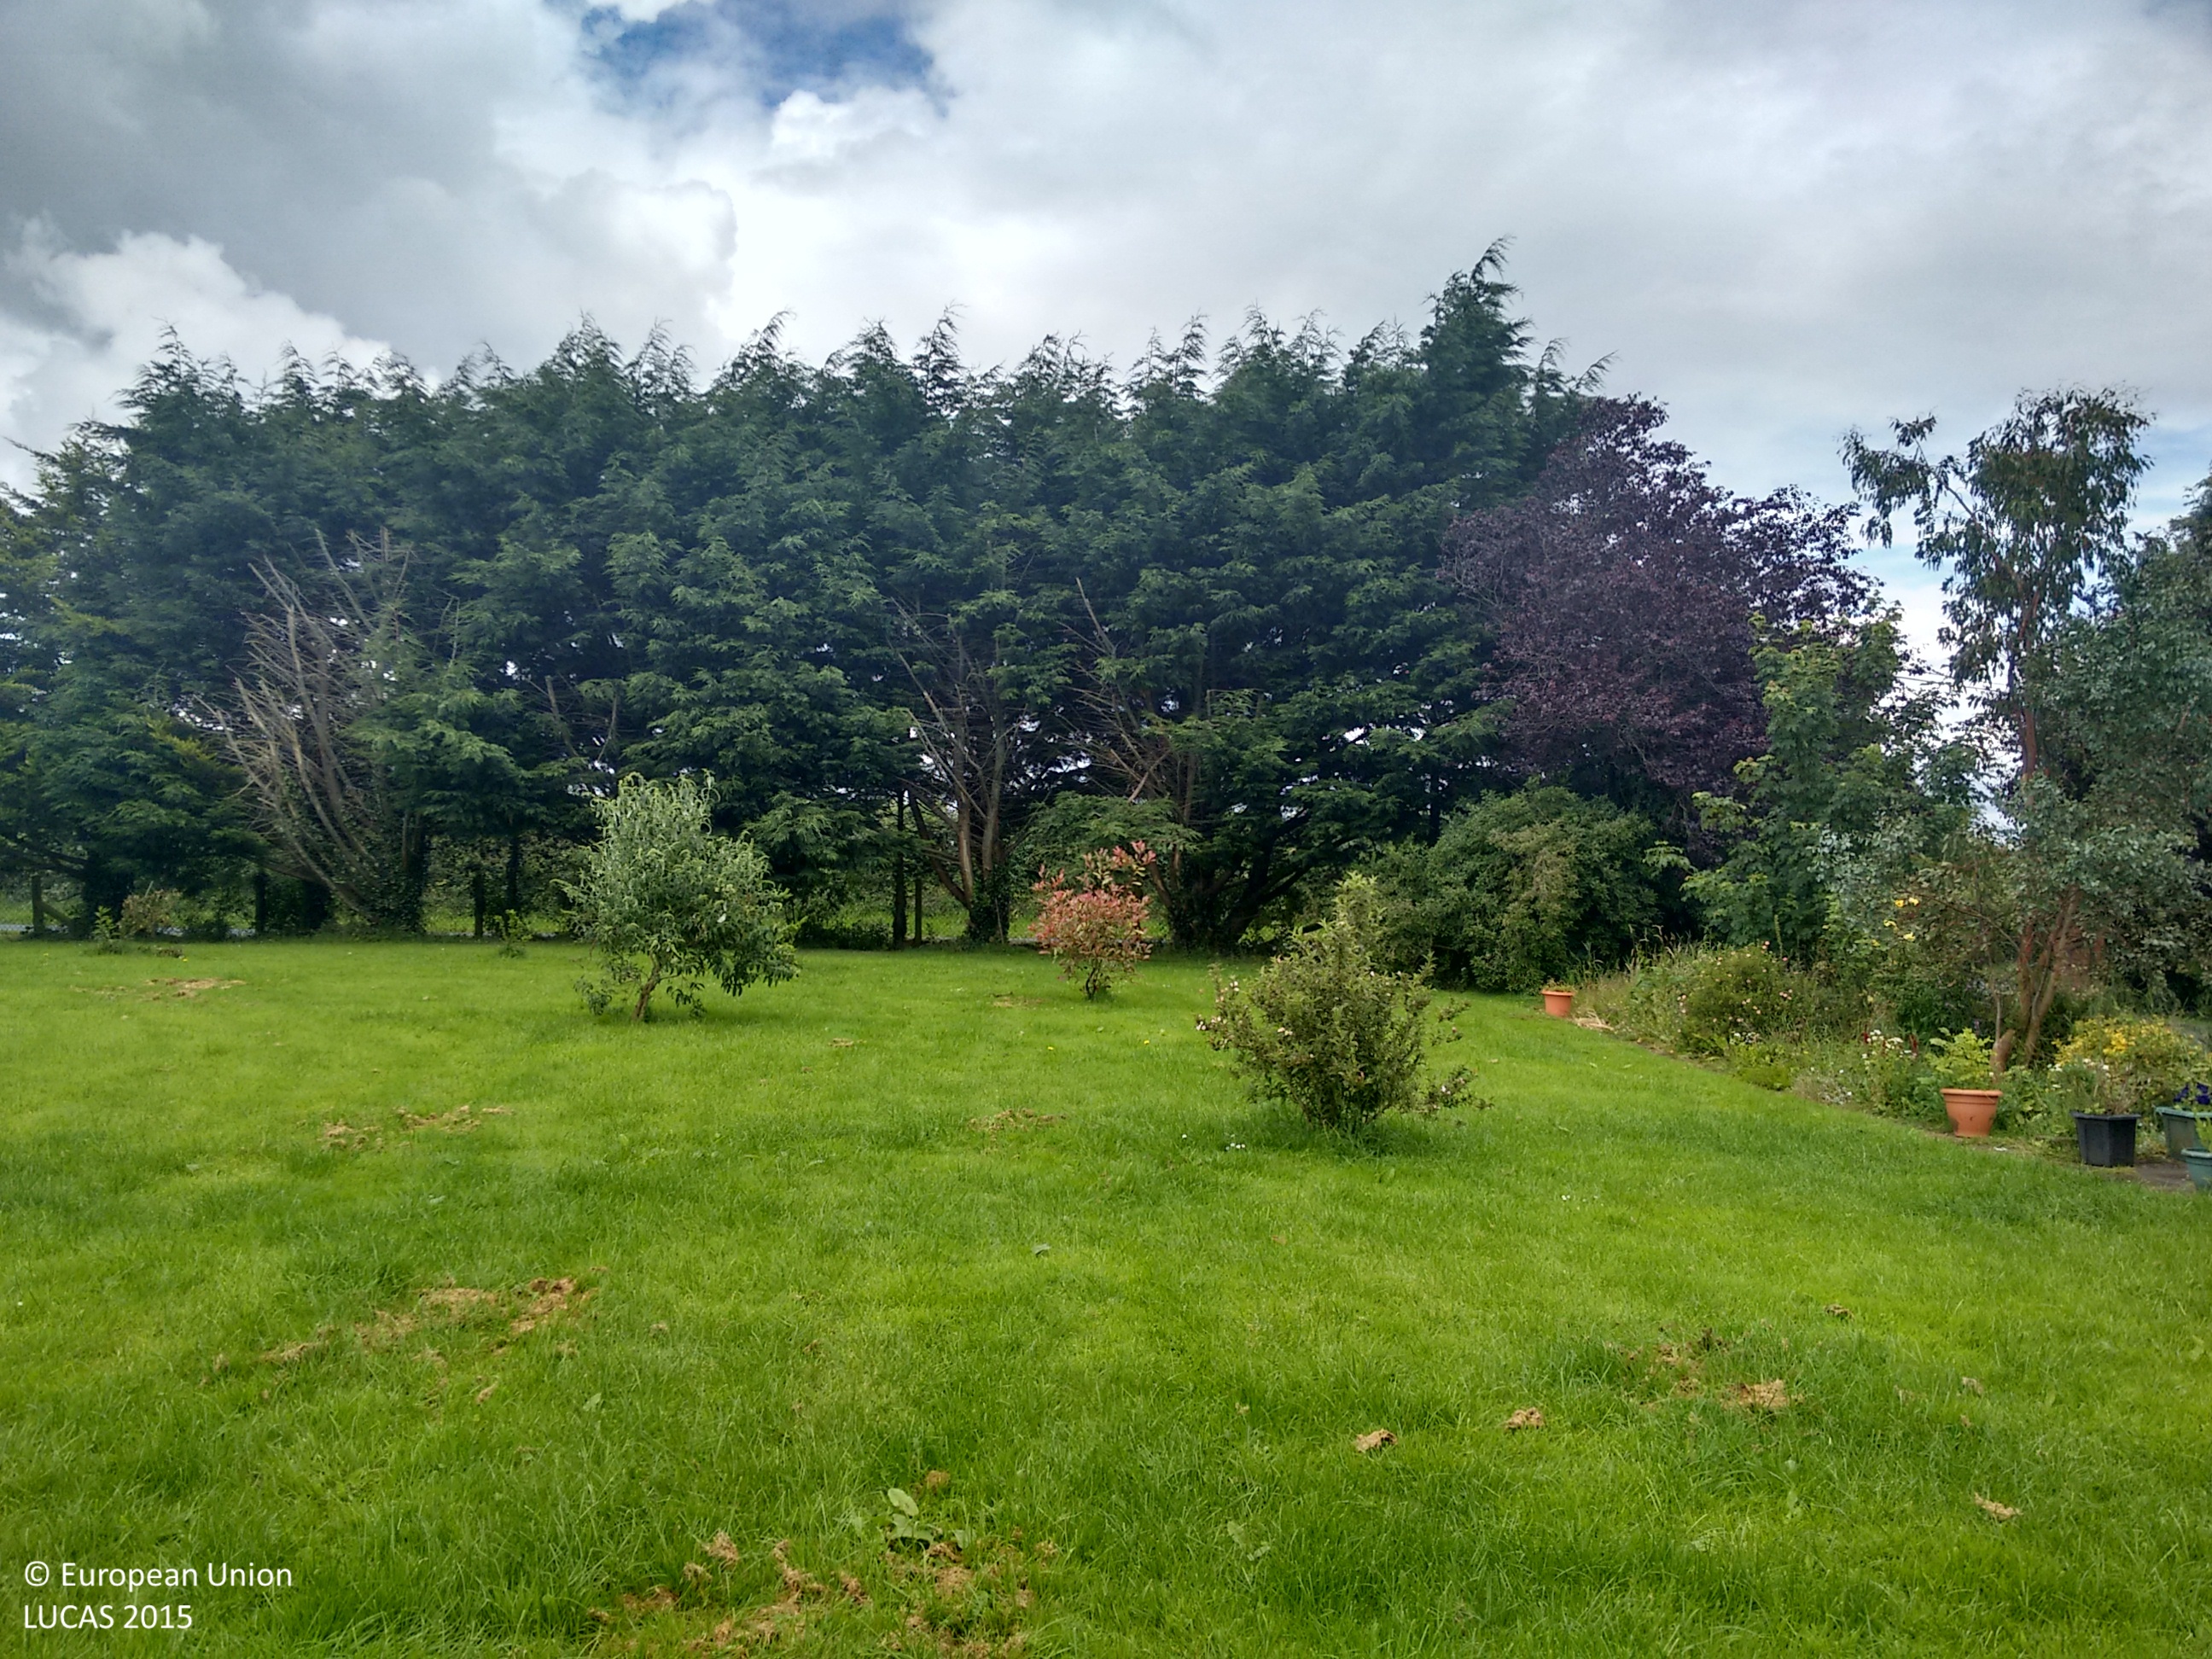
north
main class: Grassland
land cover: Grassland without tree/shrub cover
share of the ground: > 75 %
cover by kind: herbaceous plants 95 %, shrubs 5 %
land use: Residential
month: July
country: IE
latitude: 53.7324
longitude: -7.7656
